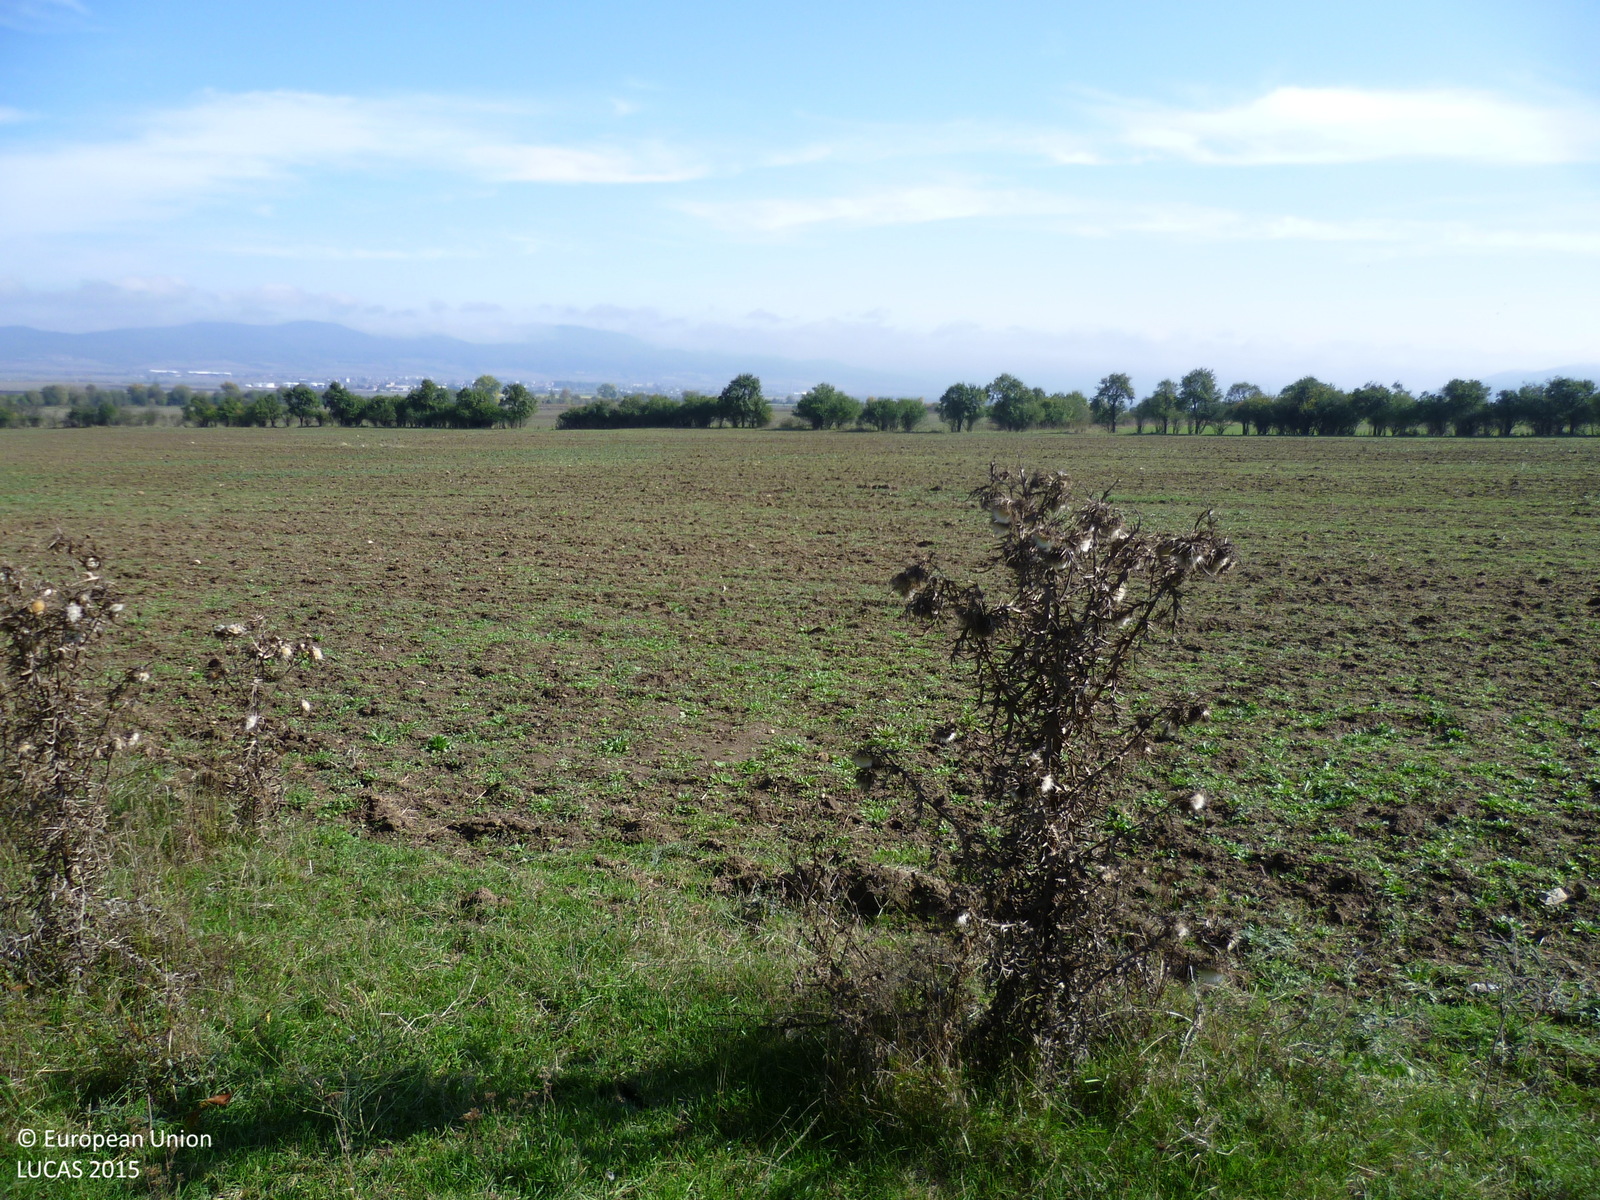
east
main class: Cropland
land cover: Cherry fruit
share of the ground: 50 - 75 %
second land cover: Grassland without tree/shrub cover
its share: > 75 %
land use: Agriculture (excluding fallow land and kitchen gardens)
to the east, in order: Cherry fruit; Grassland without tree/shrub cover; Other bare soil; Electric lines; Other bare soil; Grass margins; Abandoned hedges; Ditches and canals; Tracks; Spontaneously vegetated surfaces
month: October
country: BG
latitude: 42.4266
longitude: 23.7356
